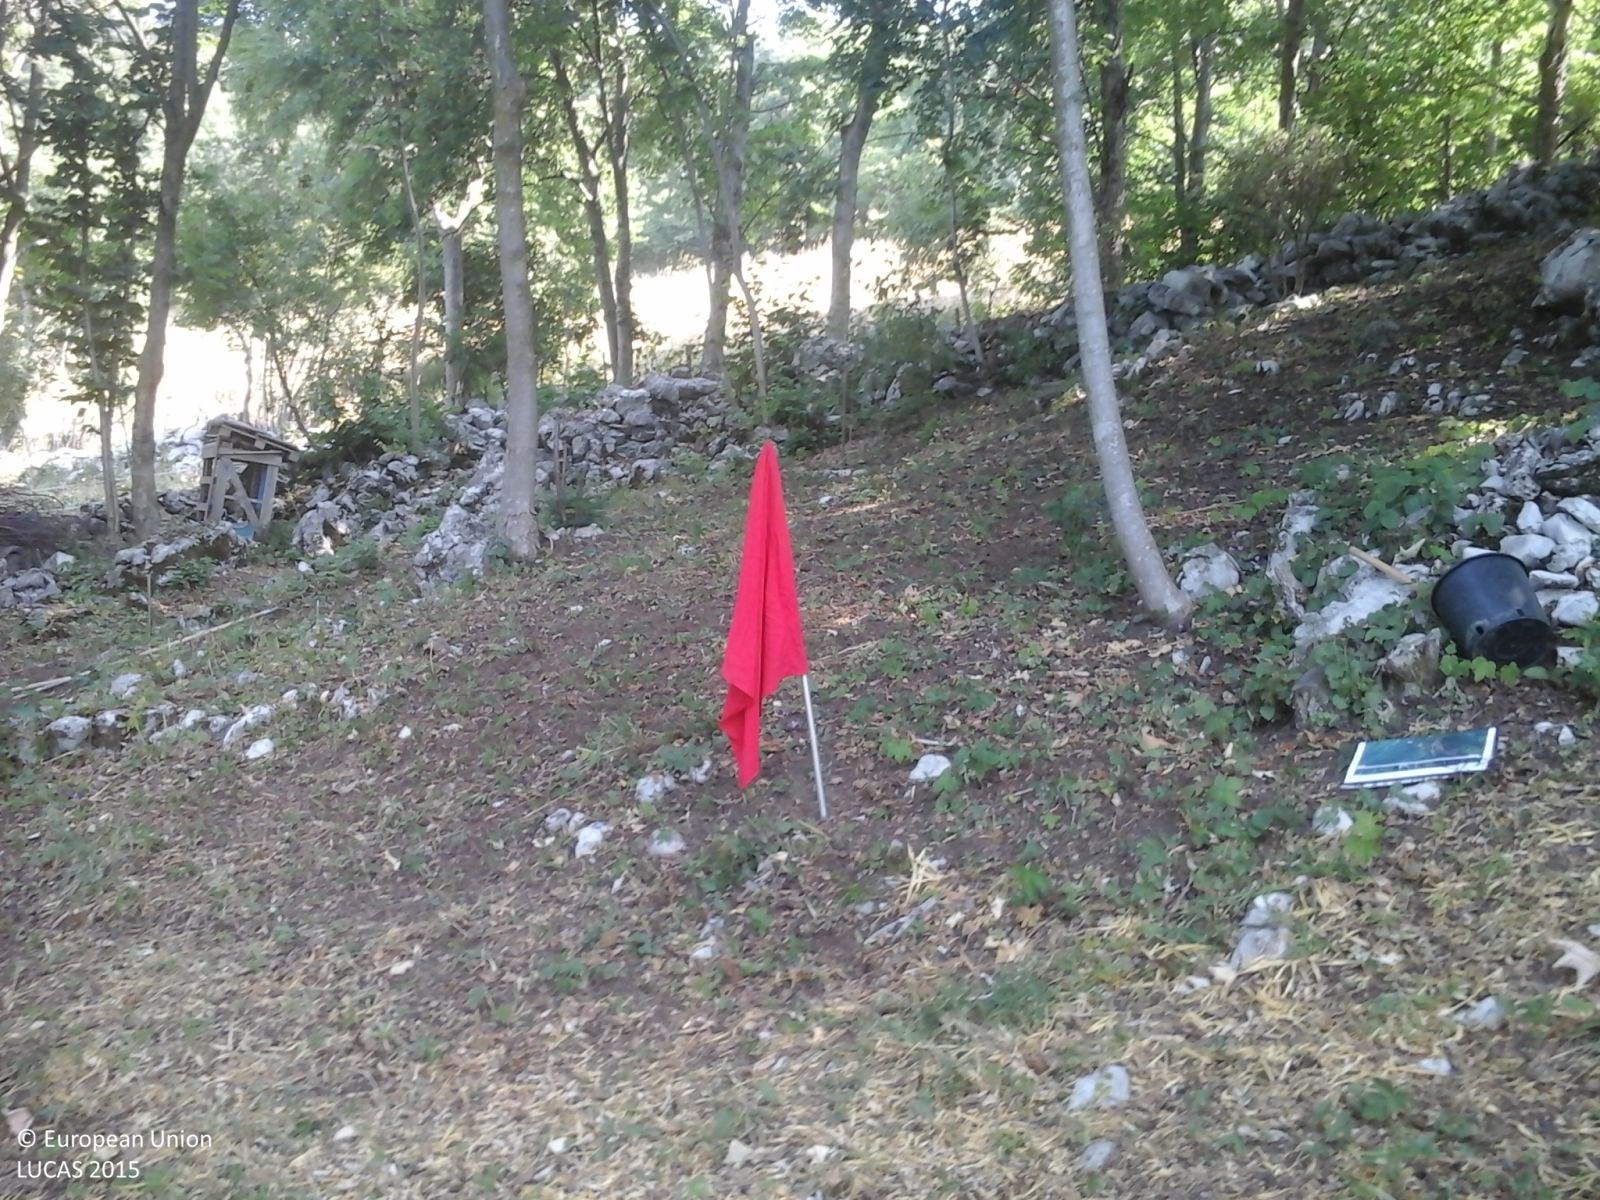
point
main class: Woodland
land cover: Broadleaved woodland
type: thermophilous deciduous forest
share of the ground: > 75 %
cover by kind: broadleaved forest trees 100 %
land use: Forestry
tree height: > 5 m
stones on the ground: 25 - 50 %
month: July
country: IT
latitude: 45.7915
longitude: 9.4991
